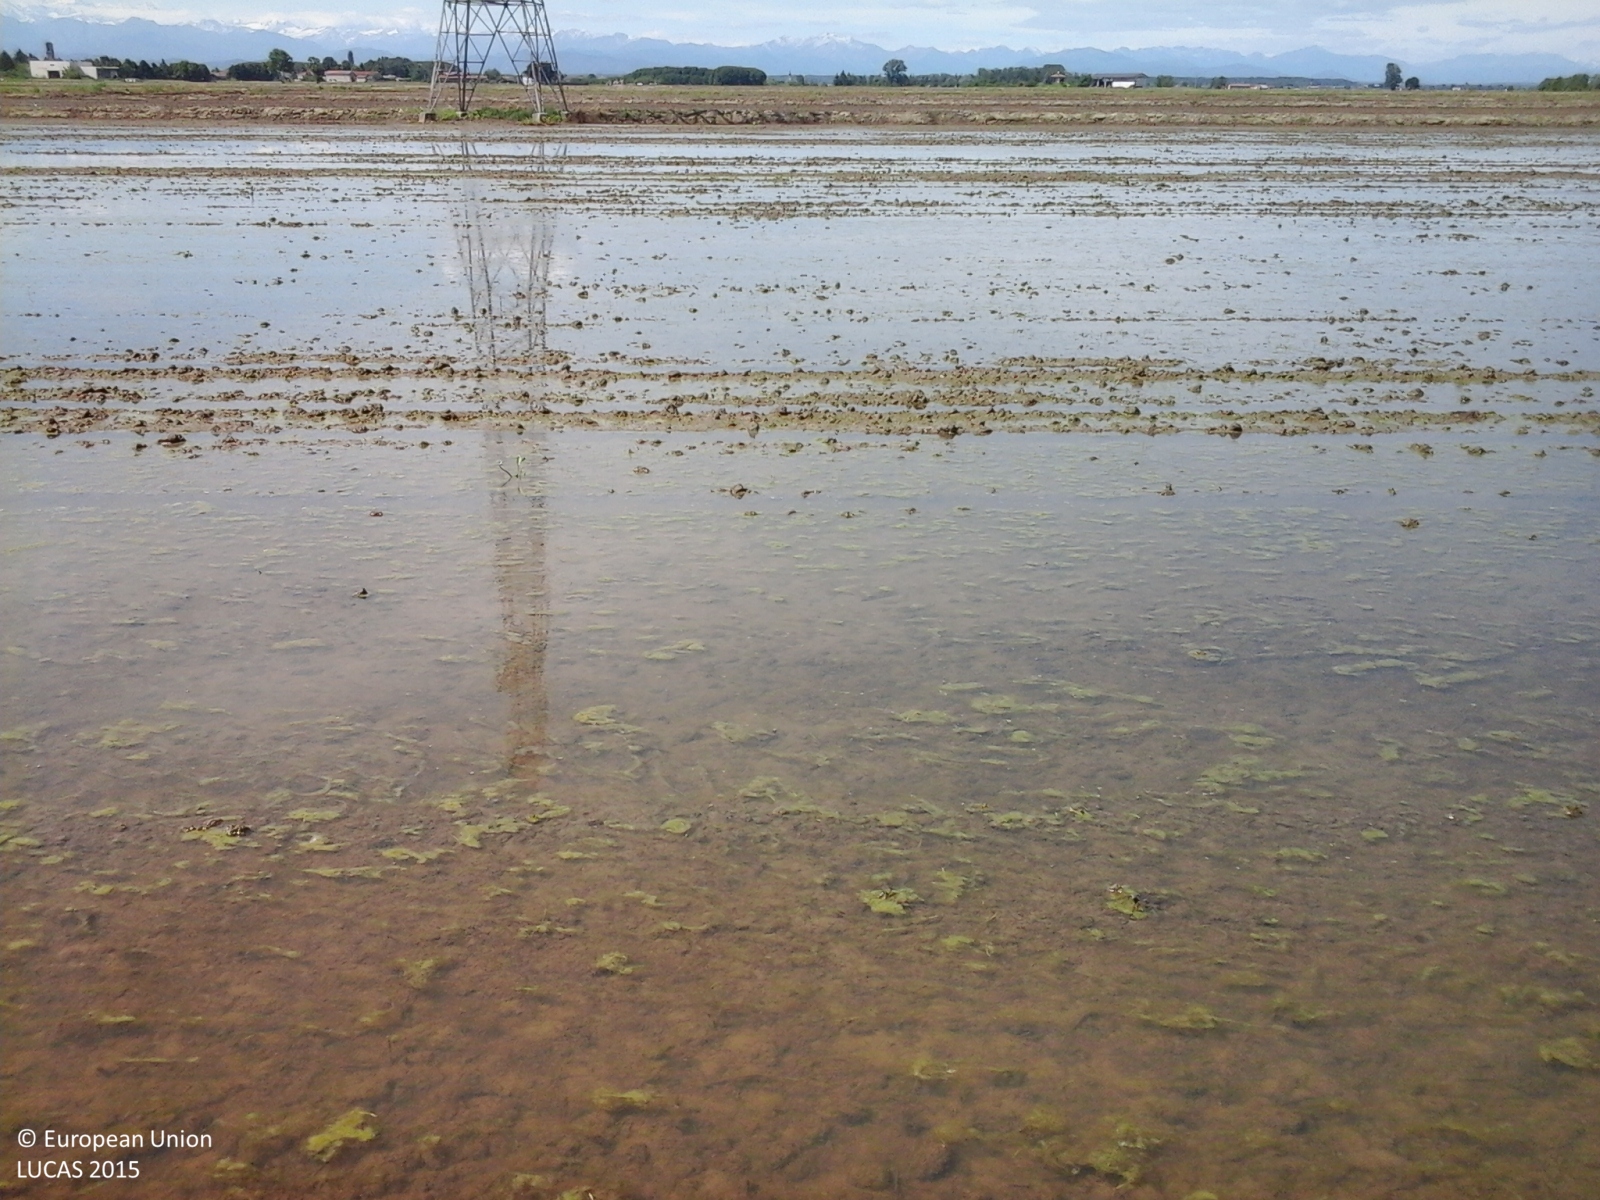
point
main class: Cropland
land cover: Rice
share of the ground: < 10 %
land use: Agriculture (excluding fallow land and kitchen gardens)
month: May
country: IT
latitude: 45.4758
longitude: 8.5058
